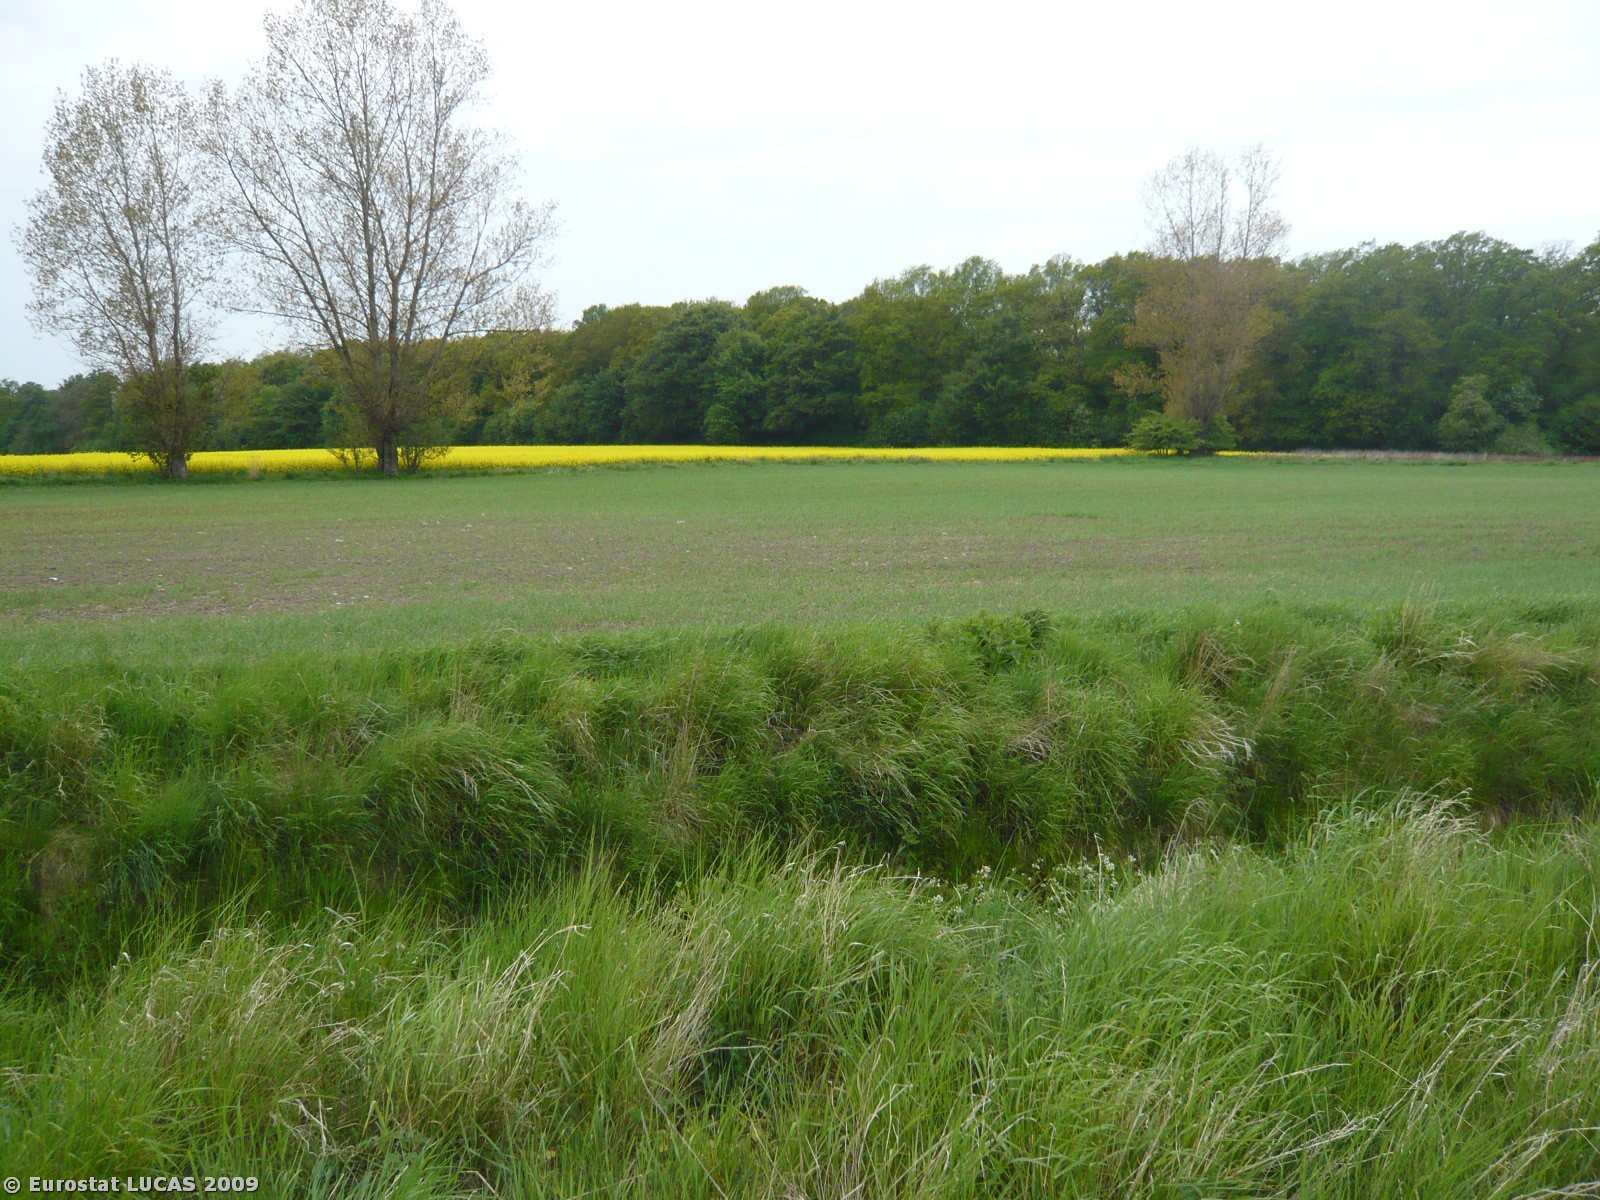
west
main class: Cropland
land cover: Barley
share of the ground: 50 - 75 %
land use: Agriculture (excluding fallow land and kitchen gardens)
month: May
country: DK
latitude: 55.3604
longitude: 12.1595
